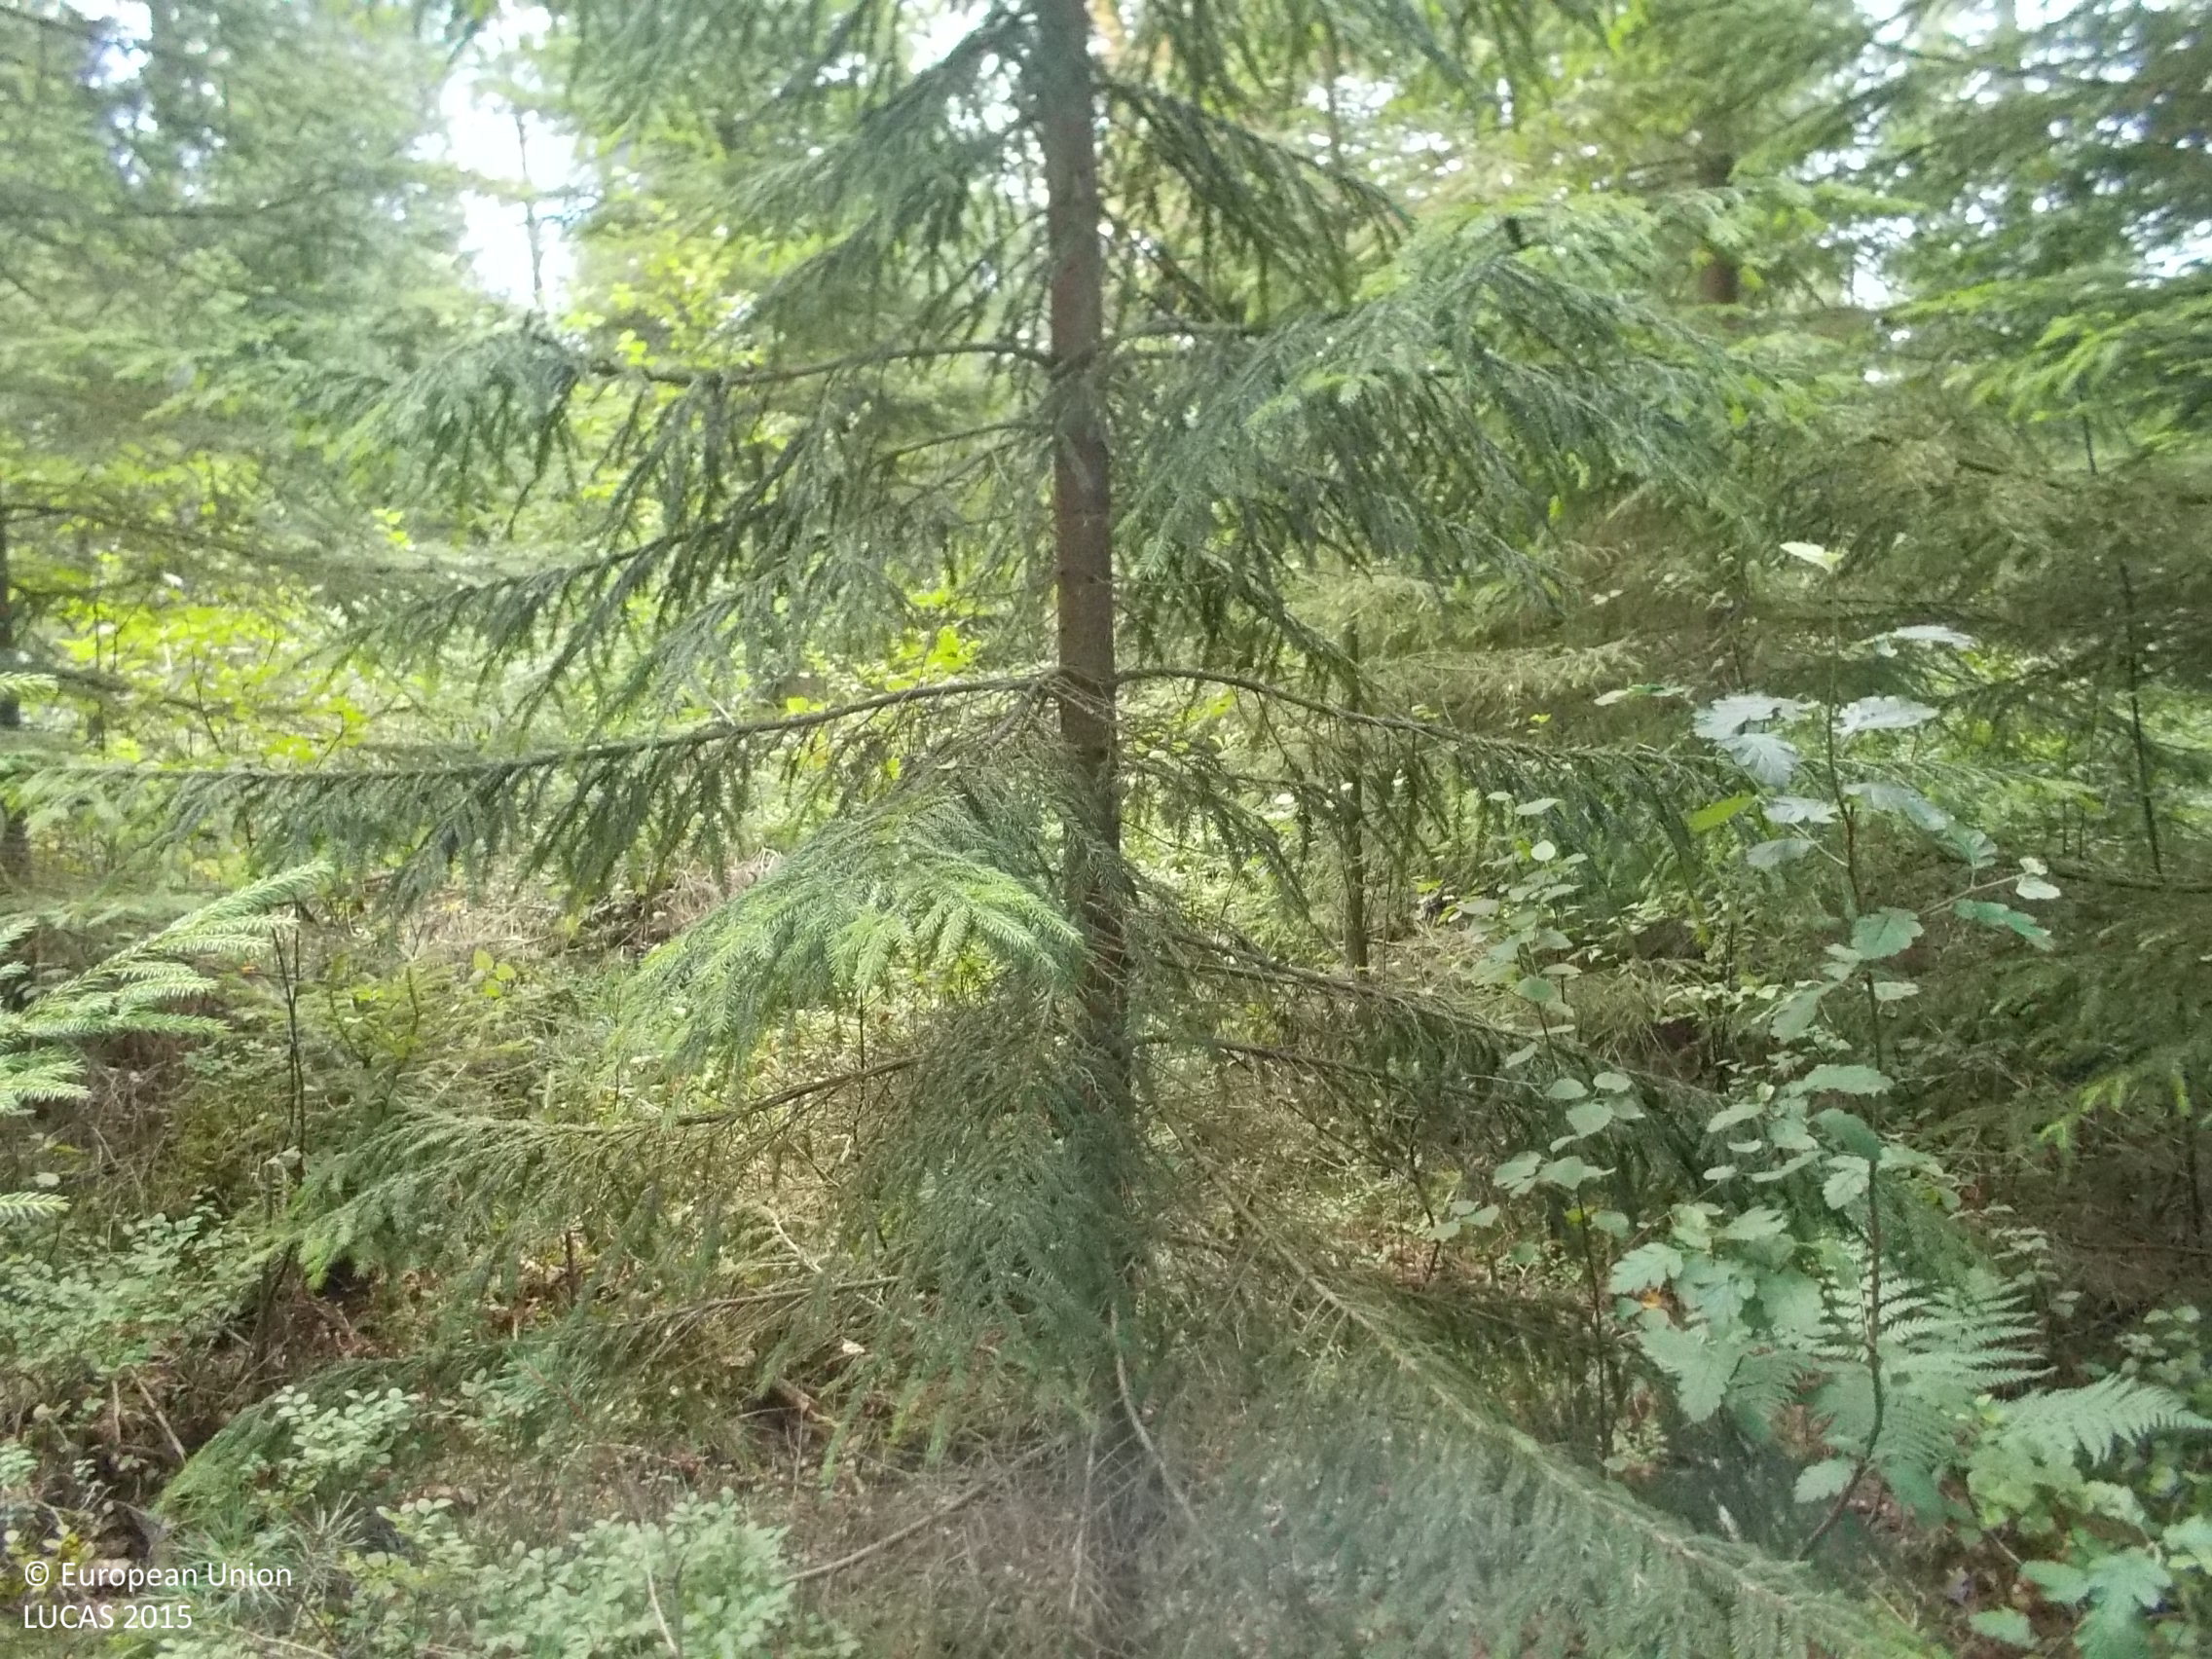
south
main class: Woodland
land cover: Spruce dominated mixed woodland
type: boreal forest
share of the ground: > 75 %
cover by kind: coniferous forest trees 60 %, broadleaved forest trees 25 %, shrubs 10 %, lichens and mosses 5 %
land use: Forestry
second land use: Sport
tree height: > 5 m
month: August
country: SE
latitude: 57.5529
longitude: 12.2525
